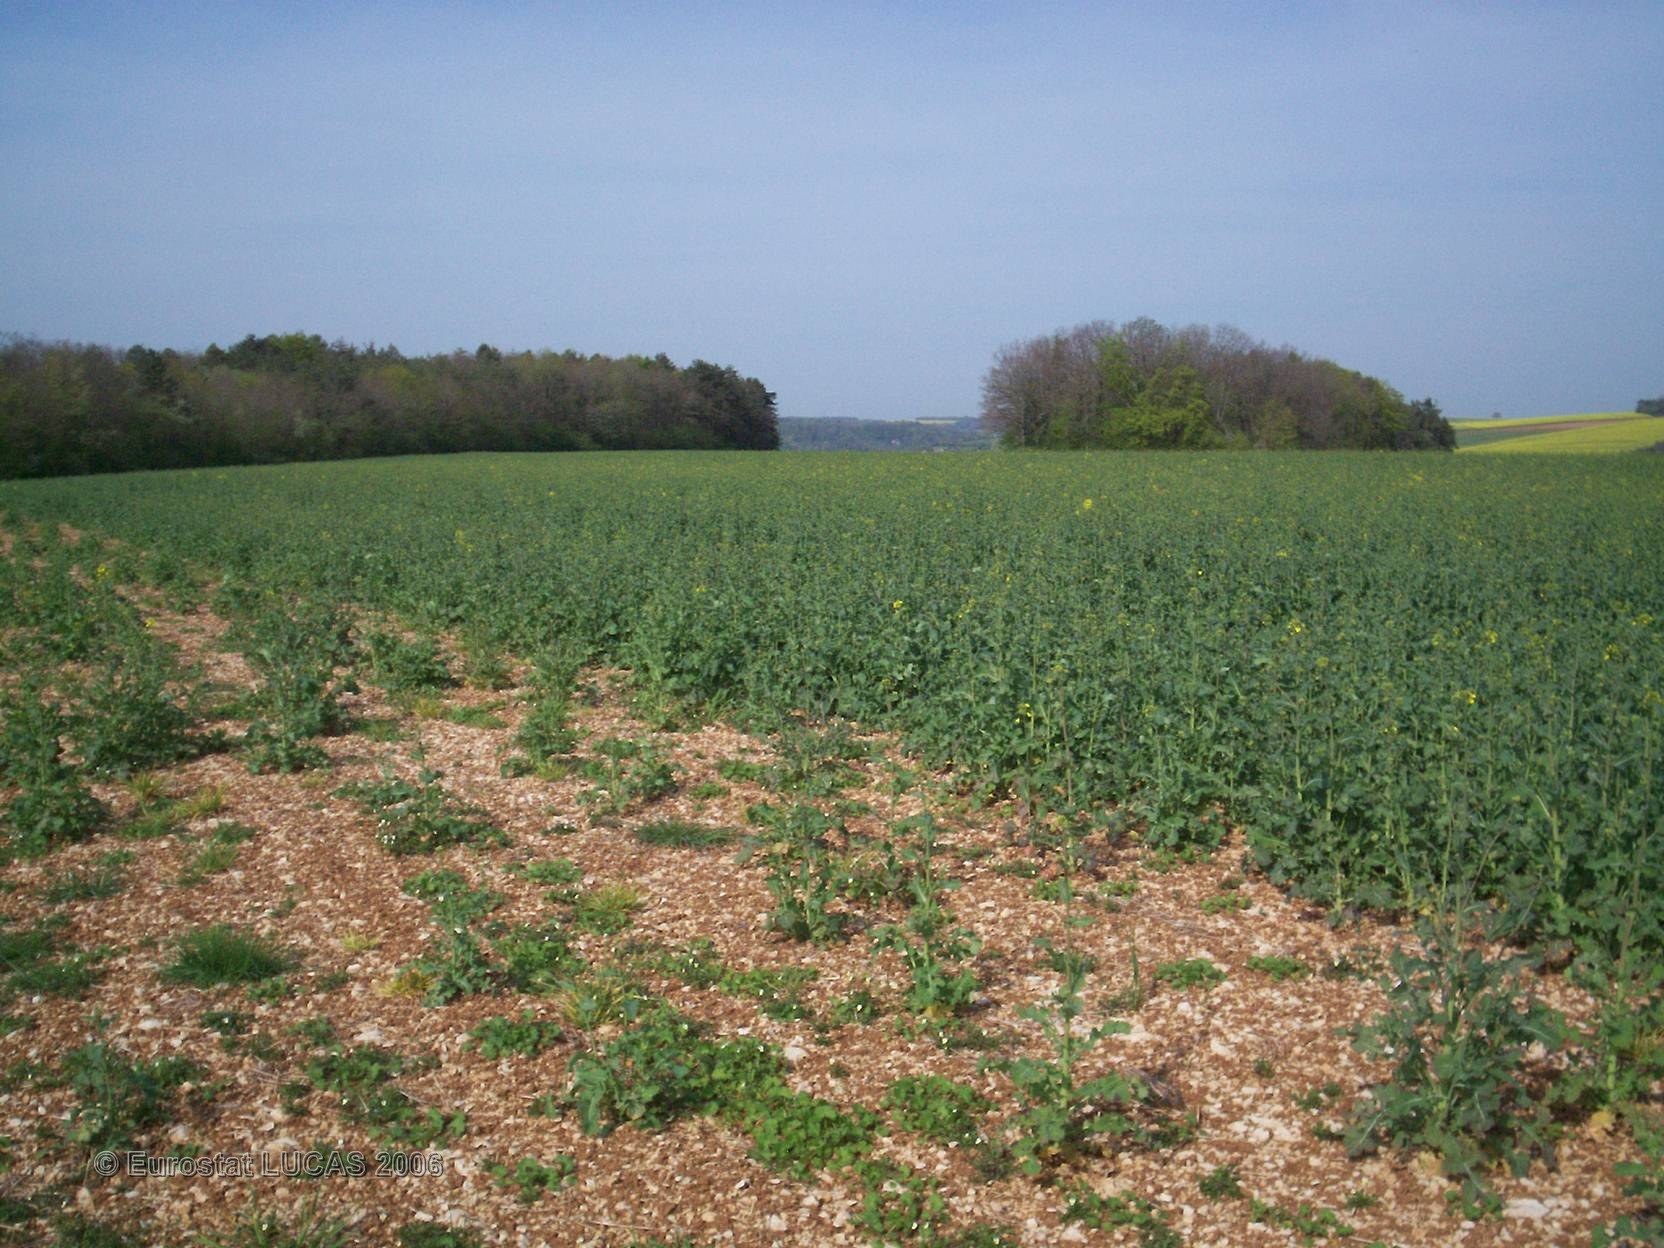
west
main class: Cropland
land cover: Rape and turnip rape
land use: Agriculture (excluding fallow land and kitchen gardens)
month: May
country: FR
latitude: 47.5843
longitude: 4.5608
